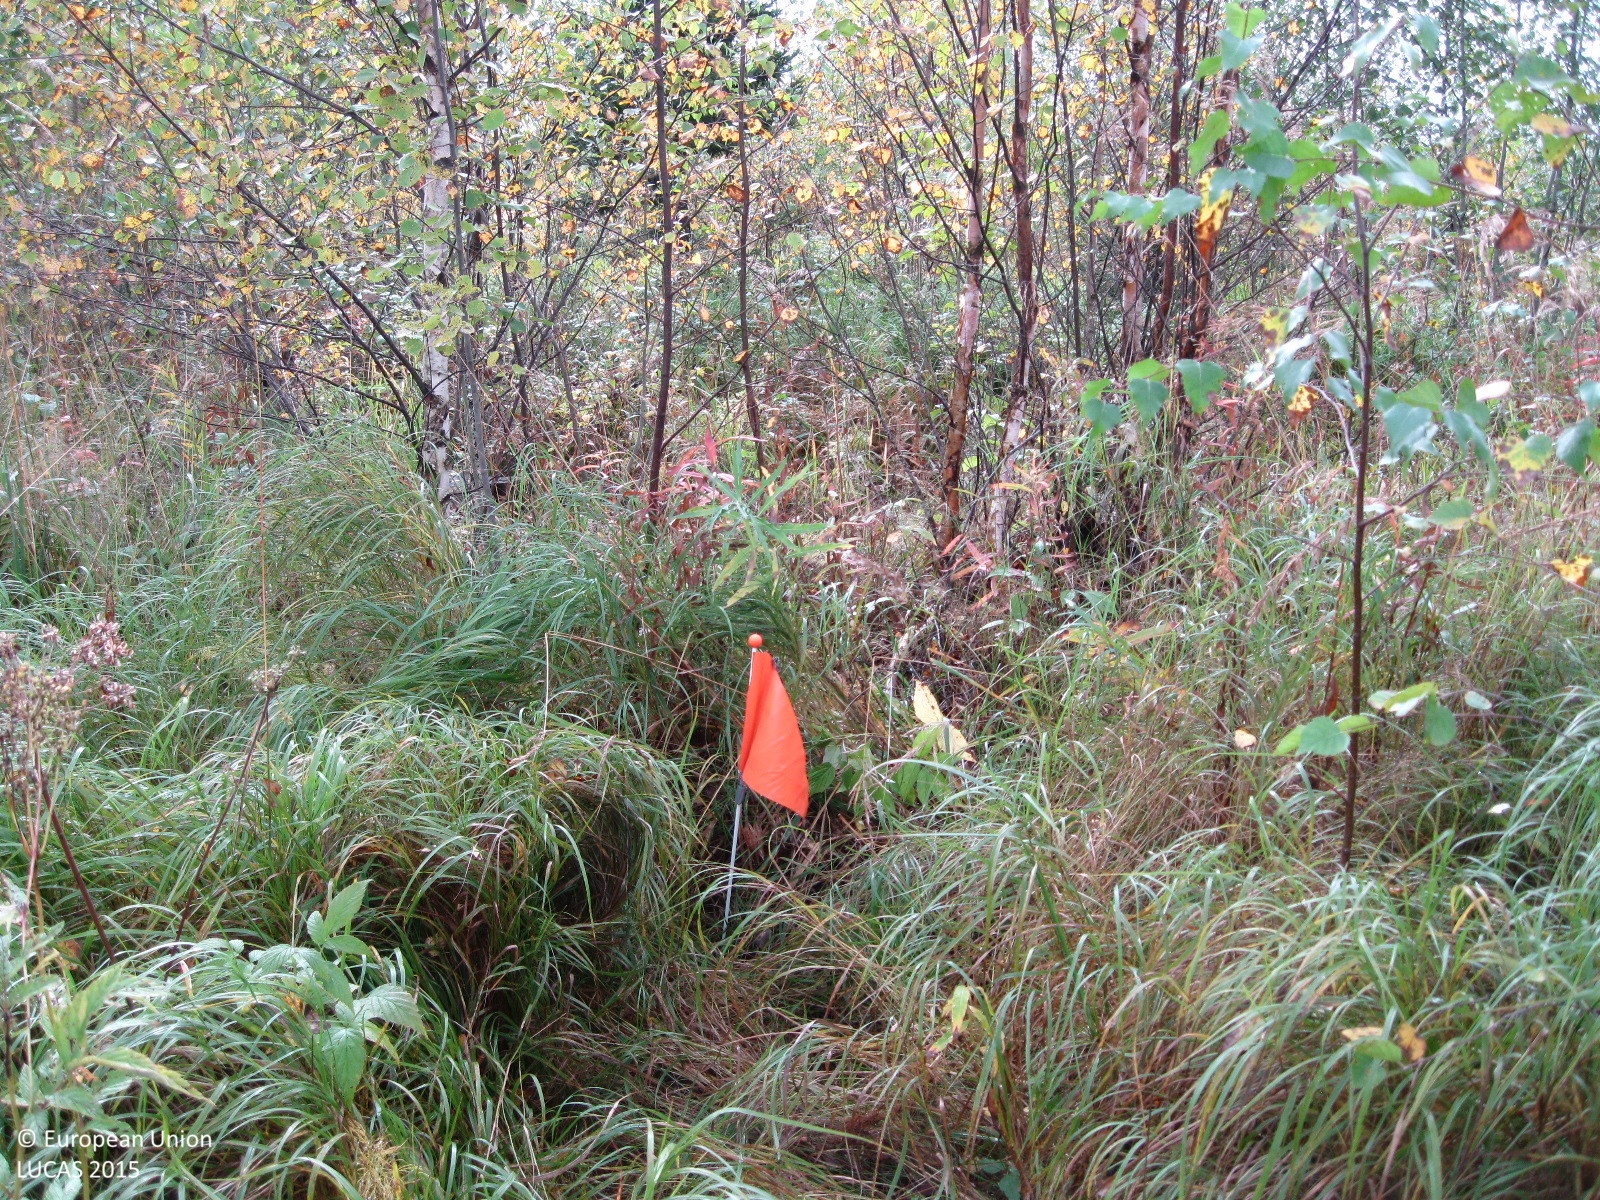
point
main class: Woodland
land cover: Broadleaved woodland
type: boreal forest
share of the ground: 50 - 75 %
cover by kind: broadleaved forest trees 65 %, herbaceous plants 25 %, coniferous forest trees 5 %, shrubs 5 %
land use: Forestry
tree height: > 5 m
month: September
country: FI
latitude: 60.7910
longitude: 24.7883
